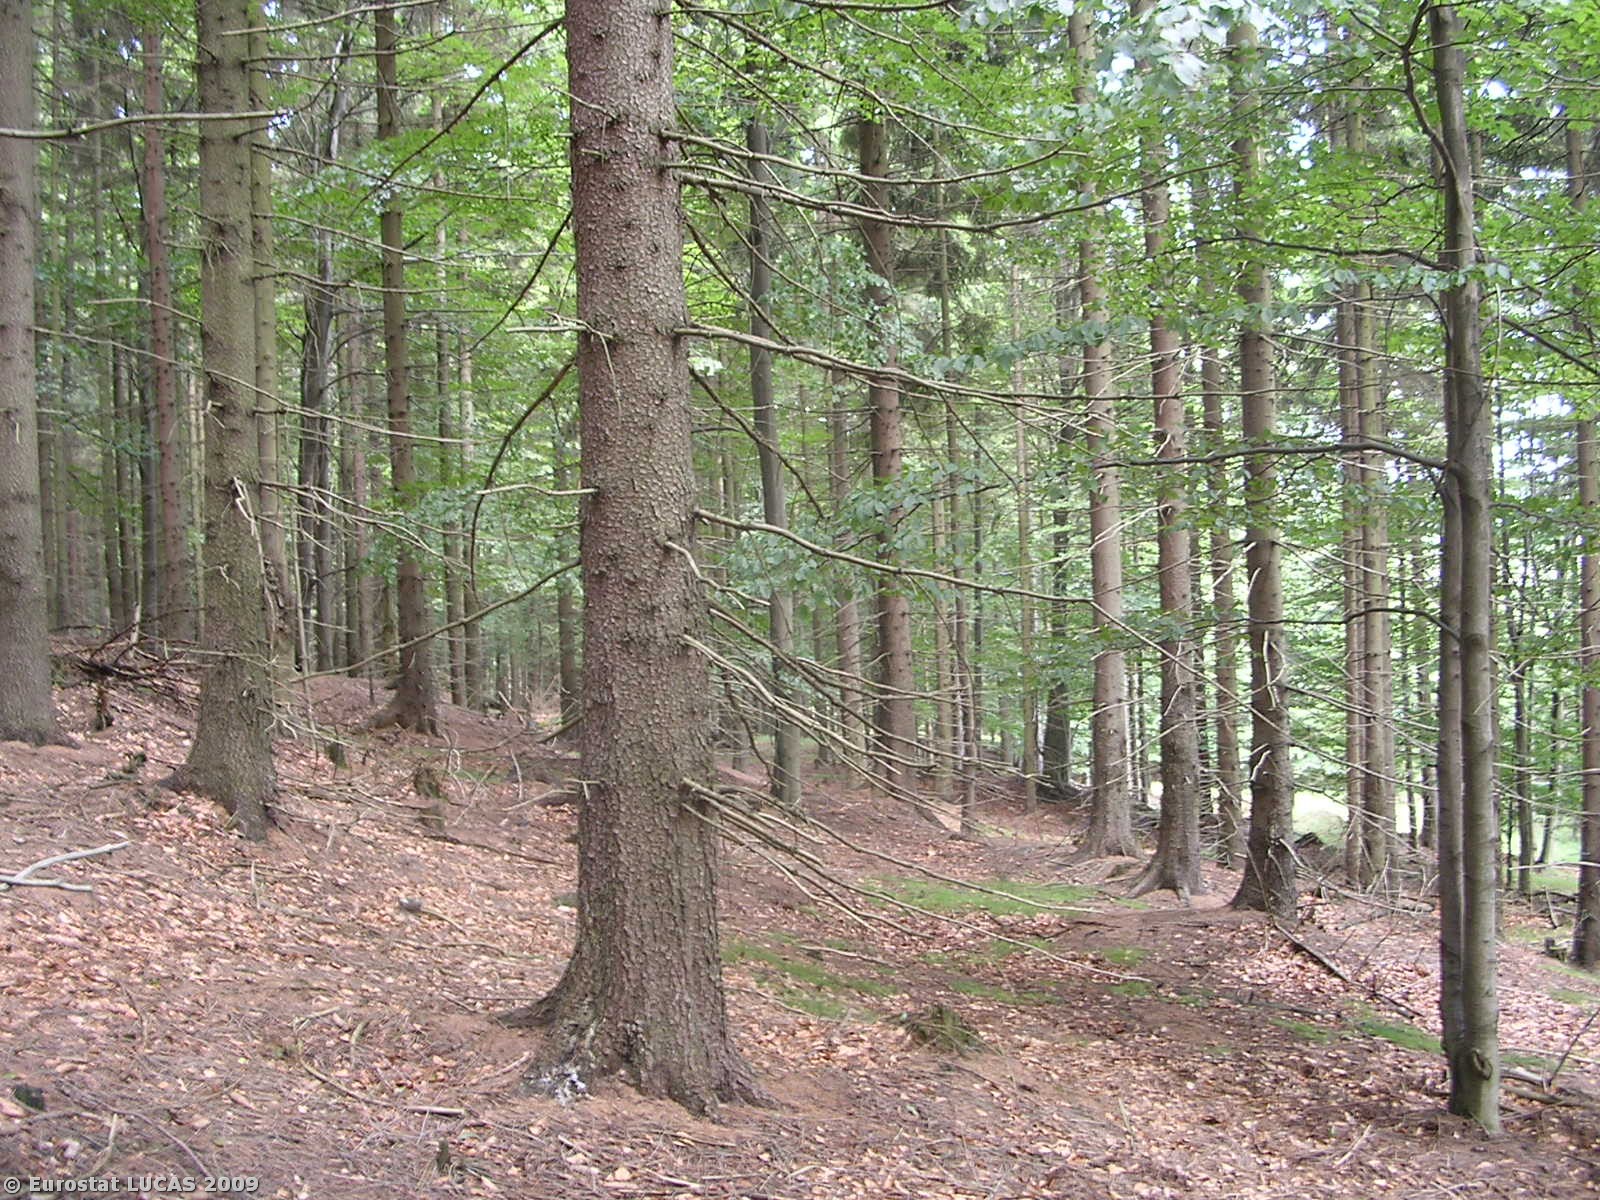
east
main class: Woodland
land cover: Mixed woodland
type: hemiboreal forest and nemoral coniferous forest and mixed broadleaved-coniferous forest
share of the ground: > 75 %
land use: Forestry
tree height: > 5 m
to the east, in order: Mixed woodland; Coniferous woodland; Mixed woodland; Tracks; Coniferous woodland
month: July
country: CZ
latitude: 50.8315
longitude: 14.5596
